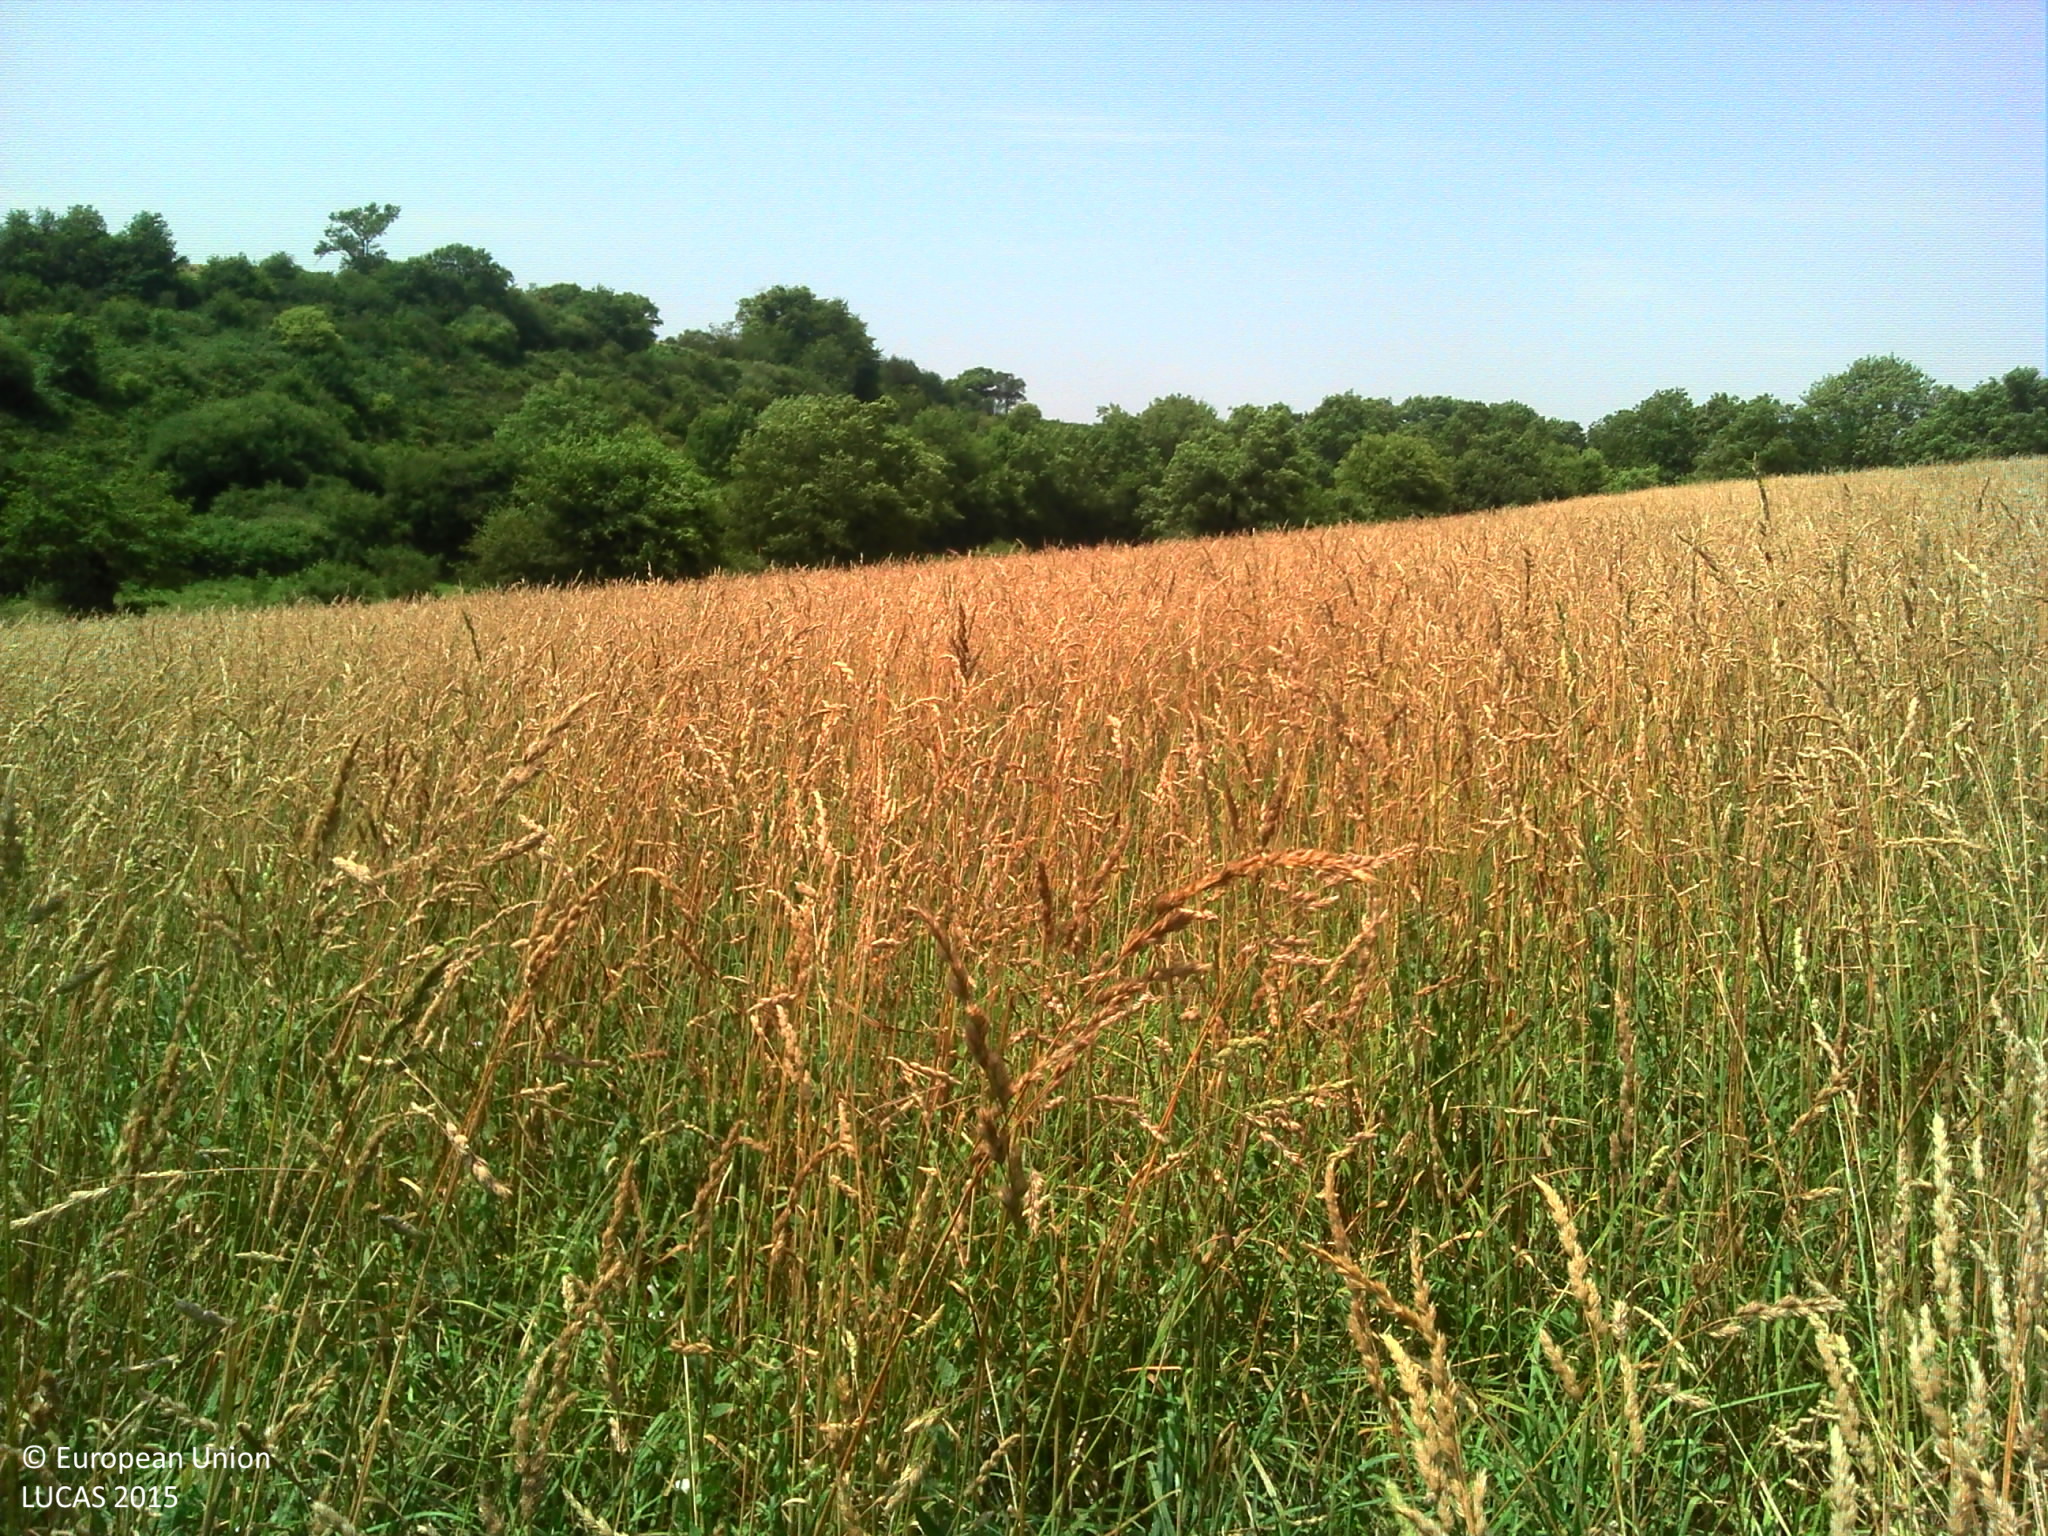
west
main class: Grassland
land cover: Grassland without tree/shrub cover
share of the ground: > 75 %
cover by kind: herbaceous plants 100 %
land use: Agriculture (excluding fallow land and kitchen gardens)
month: July
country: FR
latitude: 46.9728
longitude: -0.9036
